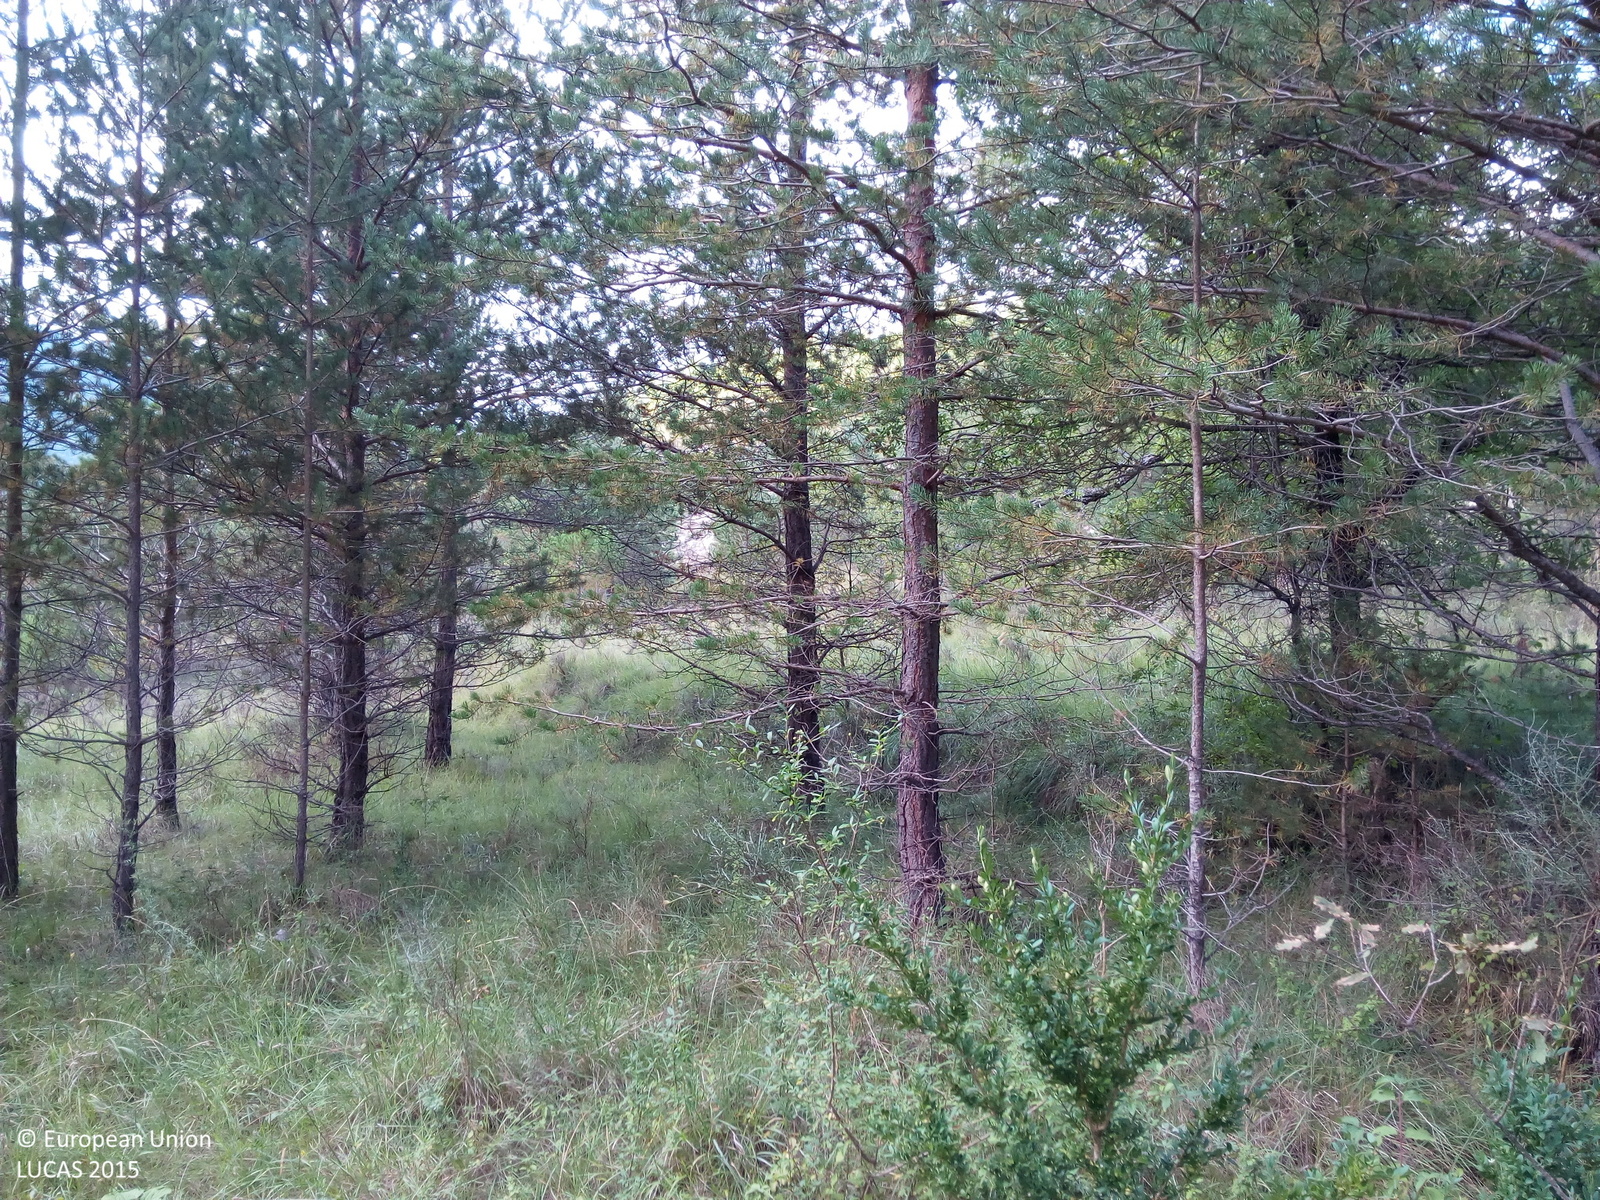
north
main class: Woodland
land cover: Broadleaved woodland
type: broadleaved evergreen forest
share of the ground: > 75 %
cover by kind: broadleaved forest trees 100 %
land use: Semi-natural and natural areas not in use
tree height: > 5 m
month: September
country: ES
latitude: 42.4639
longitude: -0.0316
